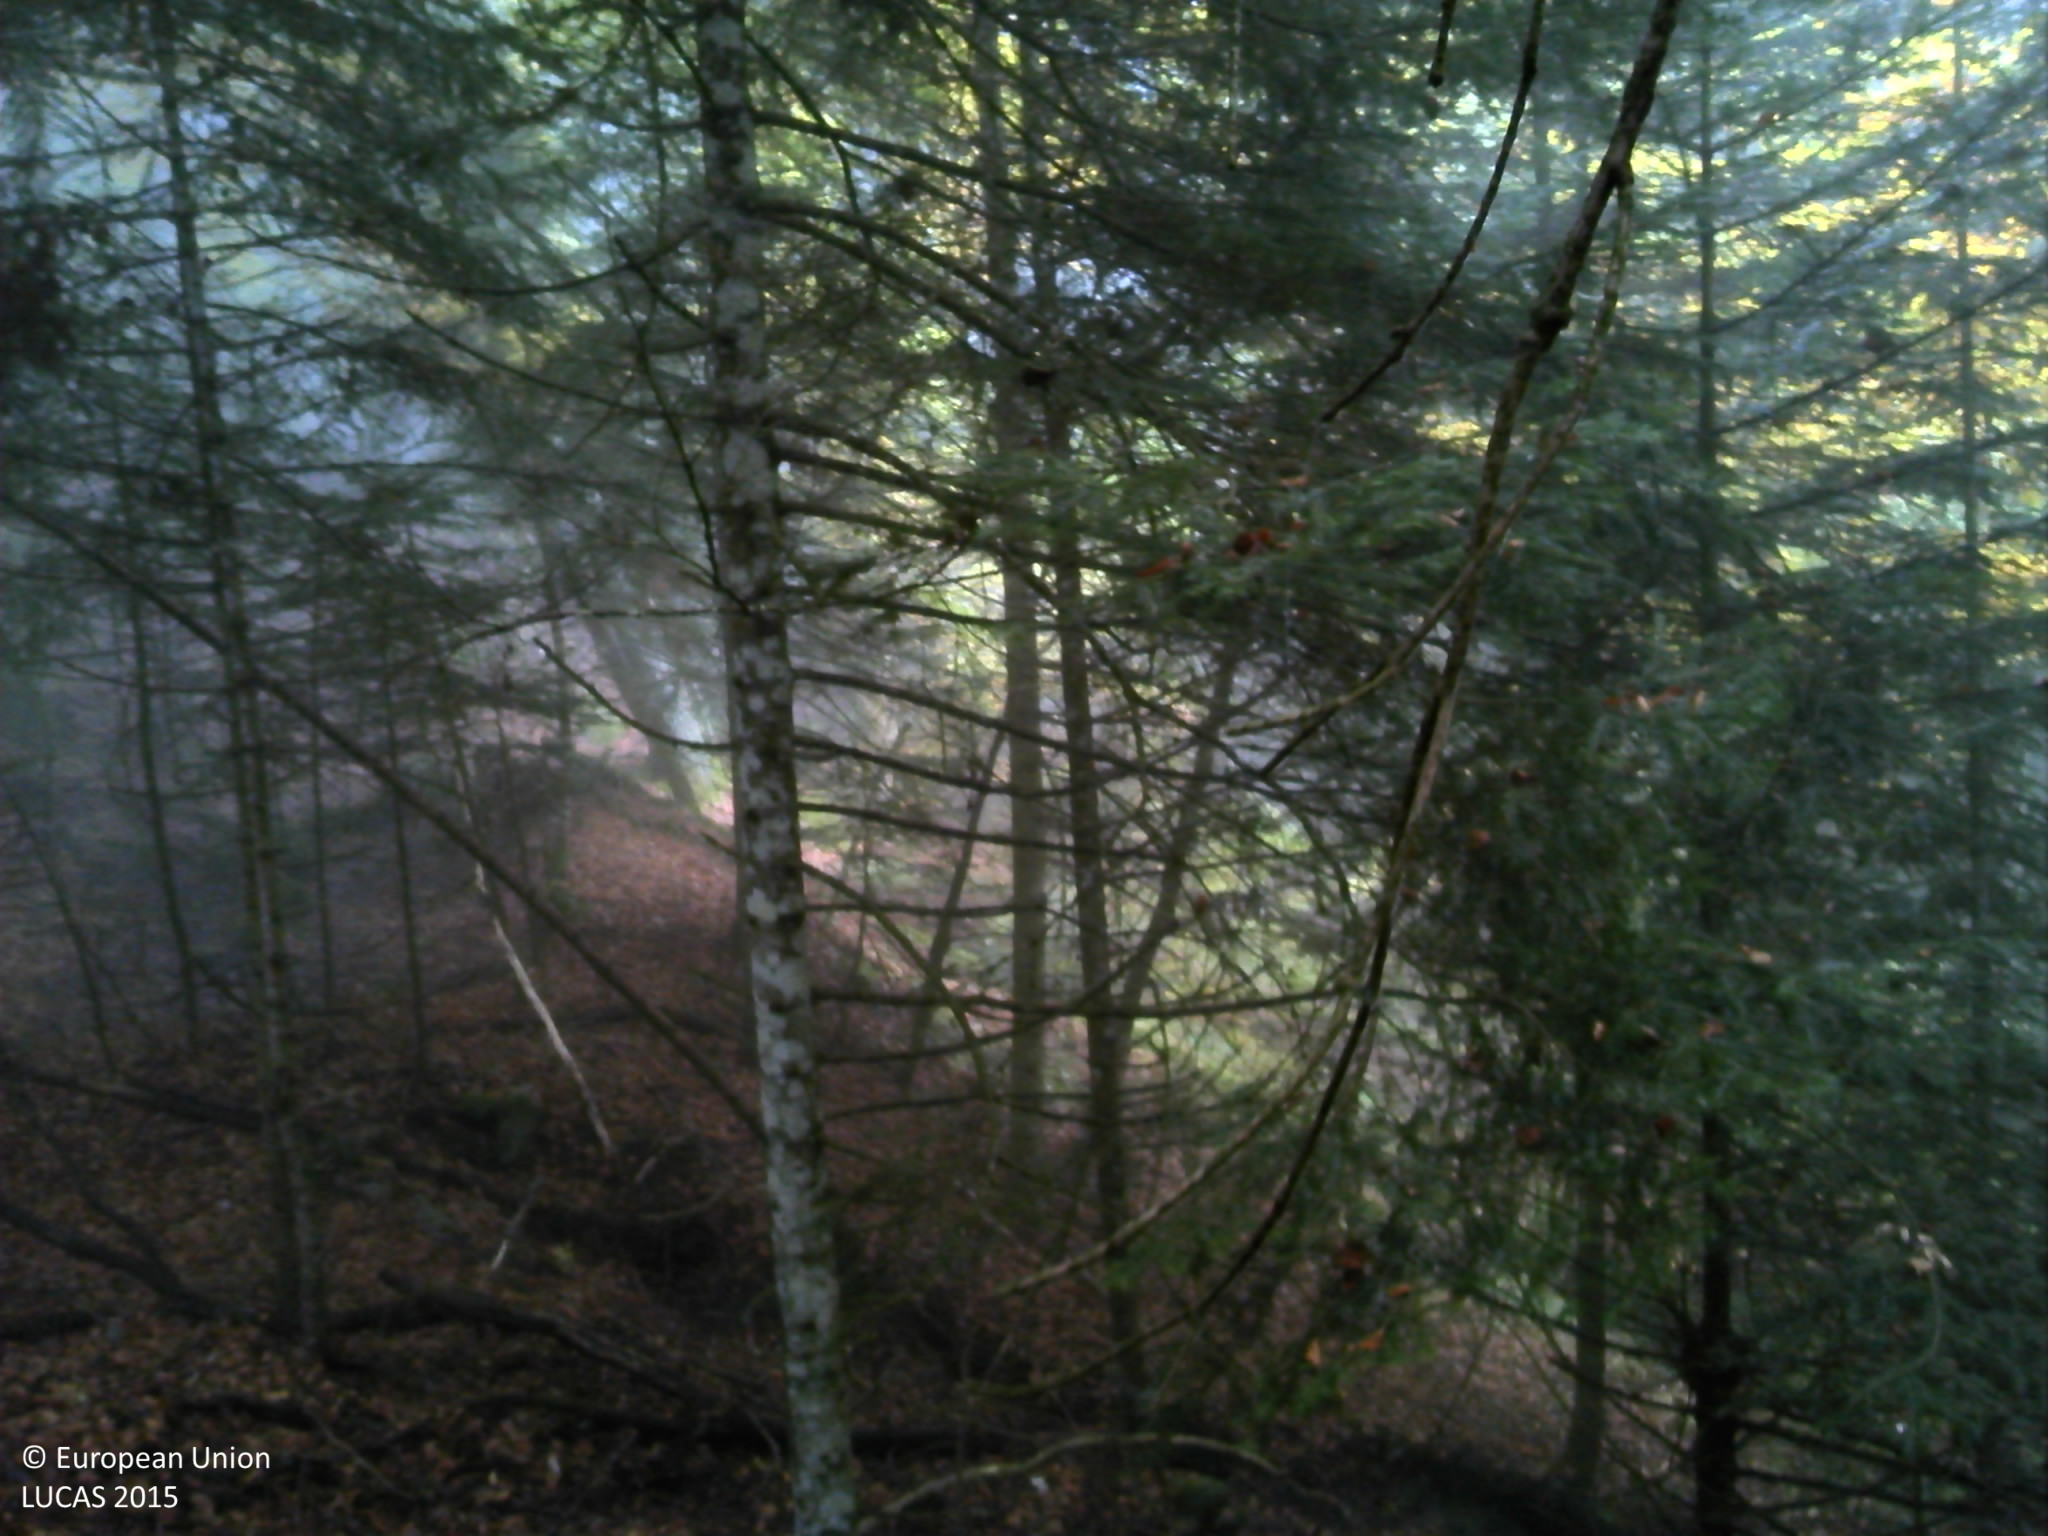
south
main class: Woodland
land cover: Spruce dominated mixed woodland
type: mountainous beech forest
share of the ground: > 75 %
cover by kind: broadleaved forest trees 50 %, coniferous forest trees 40 %, unconsolidated bare surface 10 %
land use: Forestry
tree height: > 5 m
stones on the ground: < 10 %
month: October
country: FR
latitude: 45.6447
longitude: 3.7535
